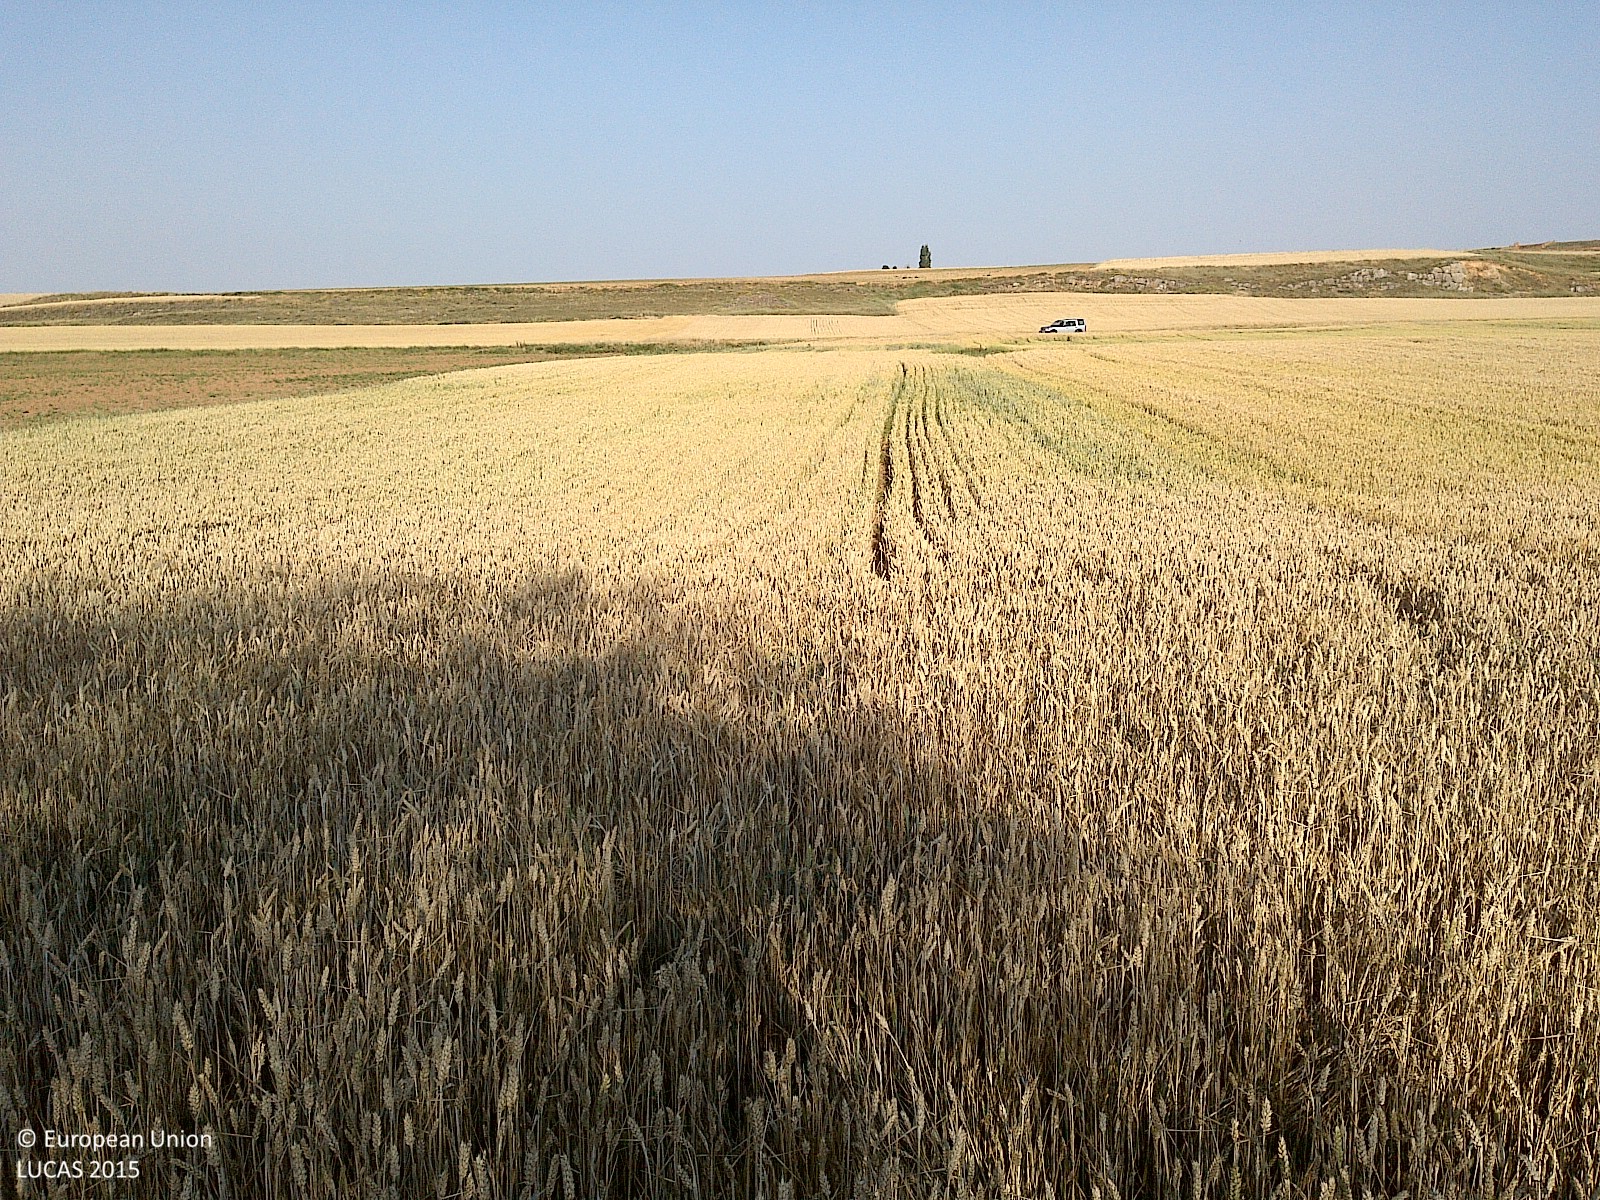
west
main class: Cropland
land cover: Common wheat
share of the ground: > 75 %
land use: Agriculture (excluding fallow land and kitchen gardens)
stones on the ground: < 10 %
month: June
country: ES
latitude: 41.6495
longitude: -2.2698
